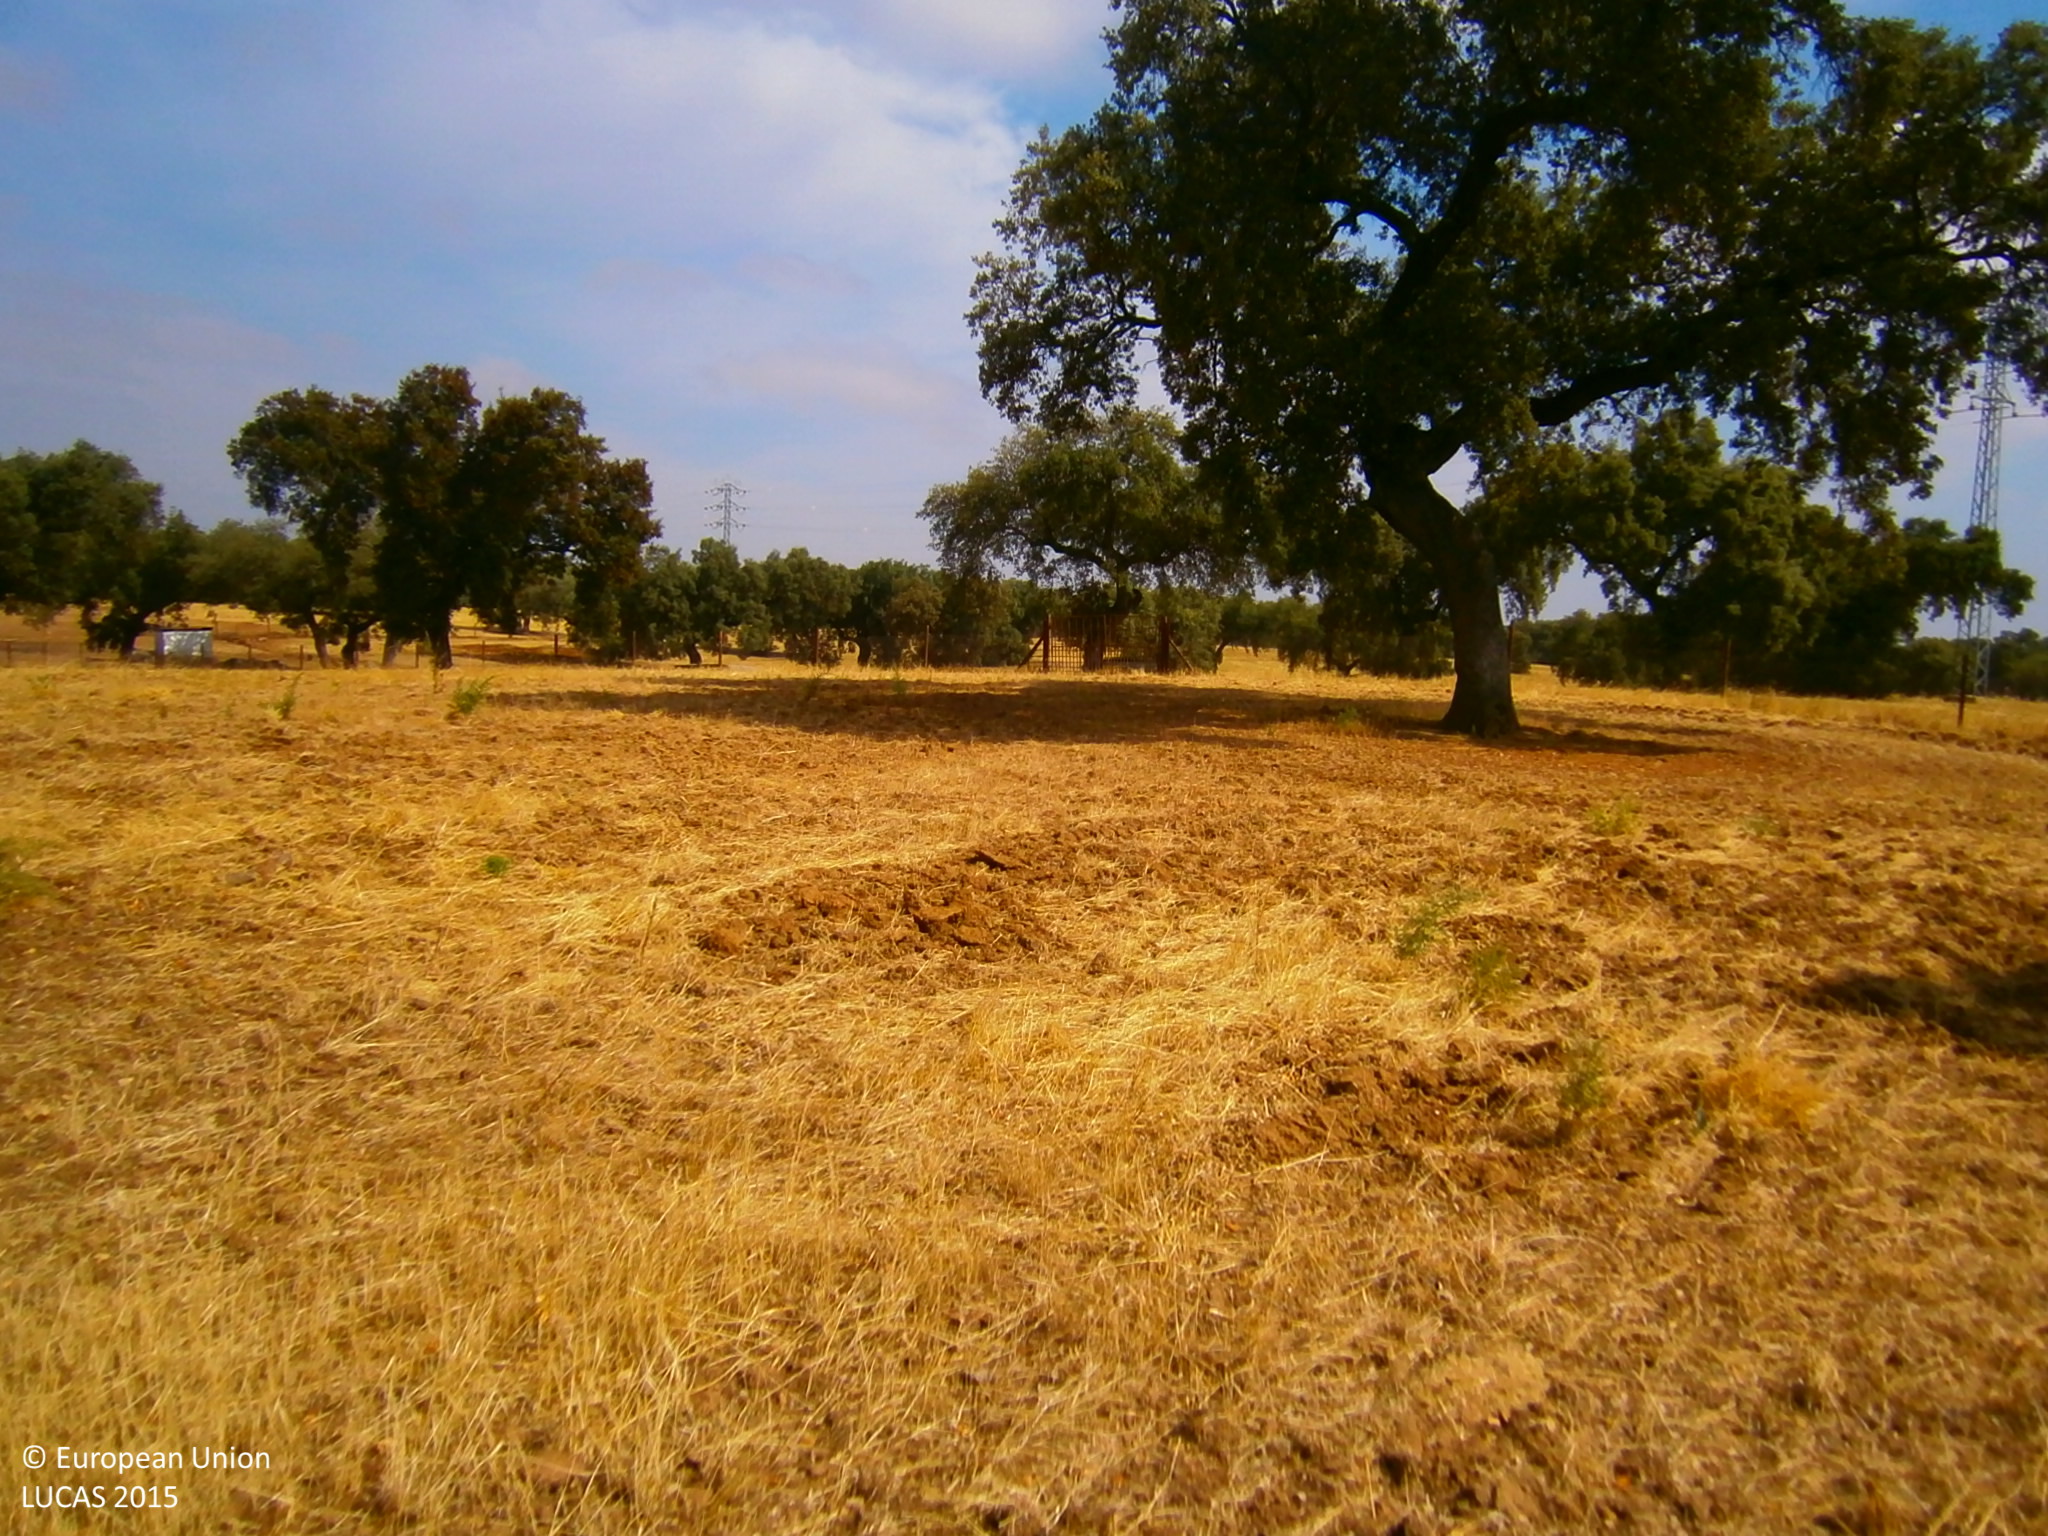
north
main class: Woodland
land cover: Broadleaved woodland
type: broadleaved evergreen forest
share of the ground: > 75 %
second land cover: Spontaneously vegetated surfaces
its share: > 75 %
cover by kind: herbaceous plants 70 %, broadleaved forest trees 20 %, shrubs 5 %, unconsolidated bare surface 5 %
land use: Forestry
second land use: Agriculture (excluding fallow land and kitchen gardens)
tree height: > 5 m
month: July
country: ES
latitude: 38.7579
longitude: -6.9723
